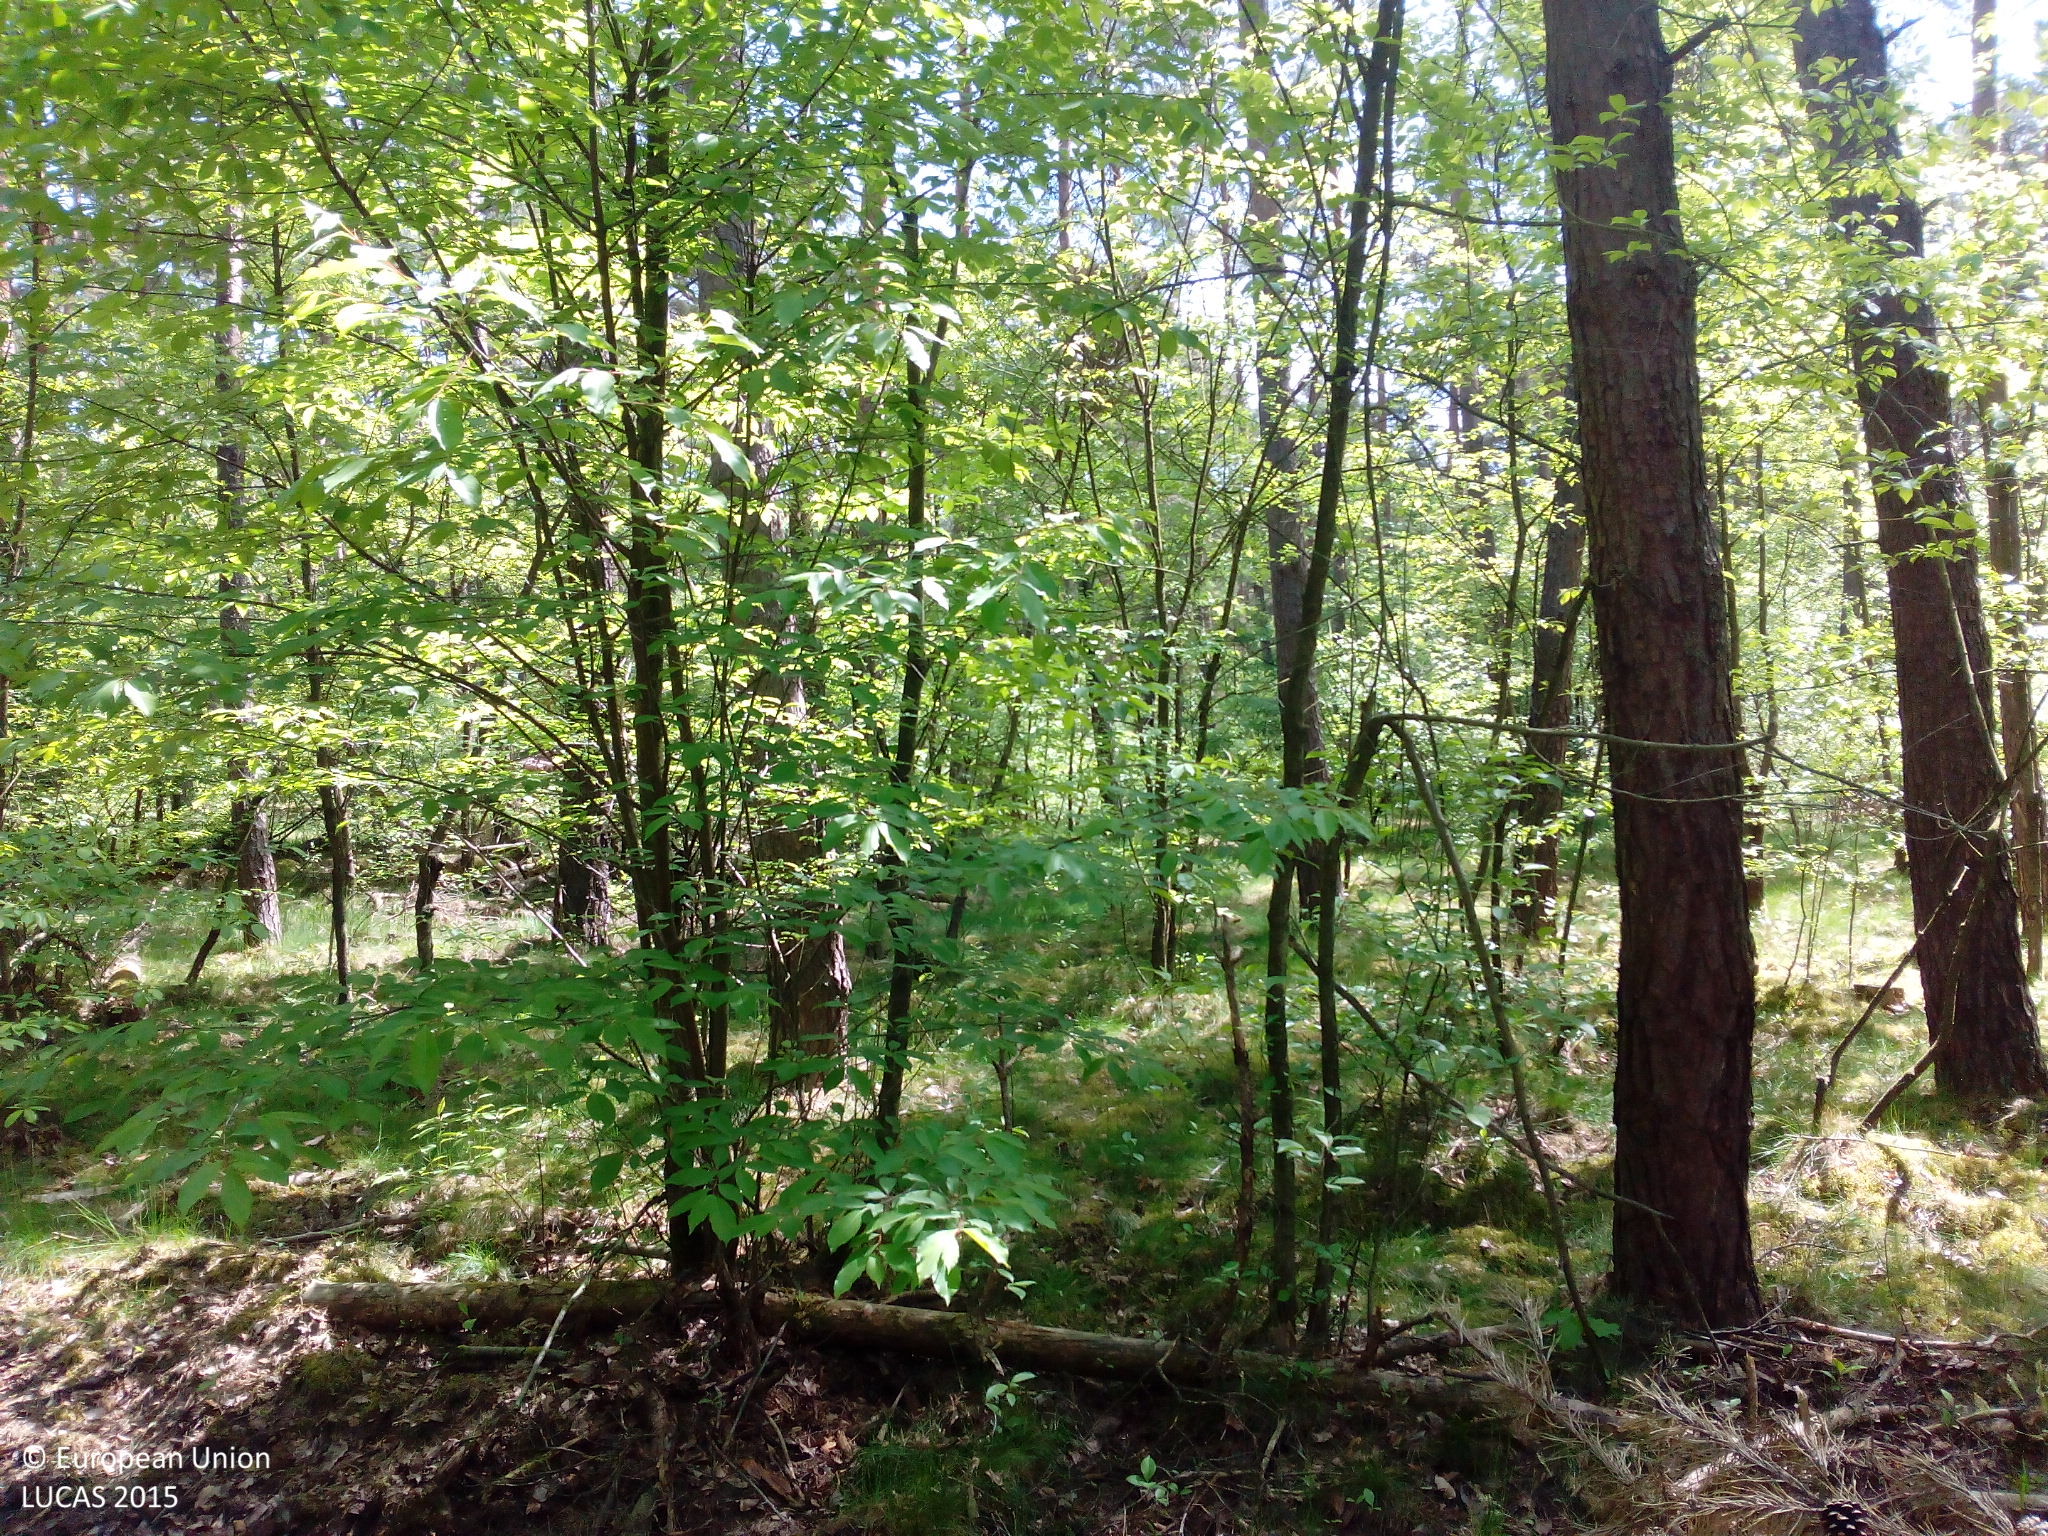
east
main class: Woodland
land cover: Pine dominated mixed woodland
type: hemiboreal forest and nemoral coniferous forest and mixed broadleaved-coniferous forest
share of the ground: 50 - 75 %
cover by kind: coniferous forest trees 40 %, broadleaved forest trees 25 %, herbaceous plants 20 %, unconsolidated bare surface 10 %, shrubs 5 %
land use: Forestry
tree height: > 5 m
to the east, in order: Pine dominated mixed woodland; Tracks; Pine dominated mixed woodland; Tracks; Pine dominated mixed woodland
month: May
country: DE
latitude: 49.5811
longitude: 8.5205
